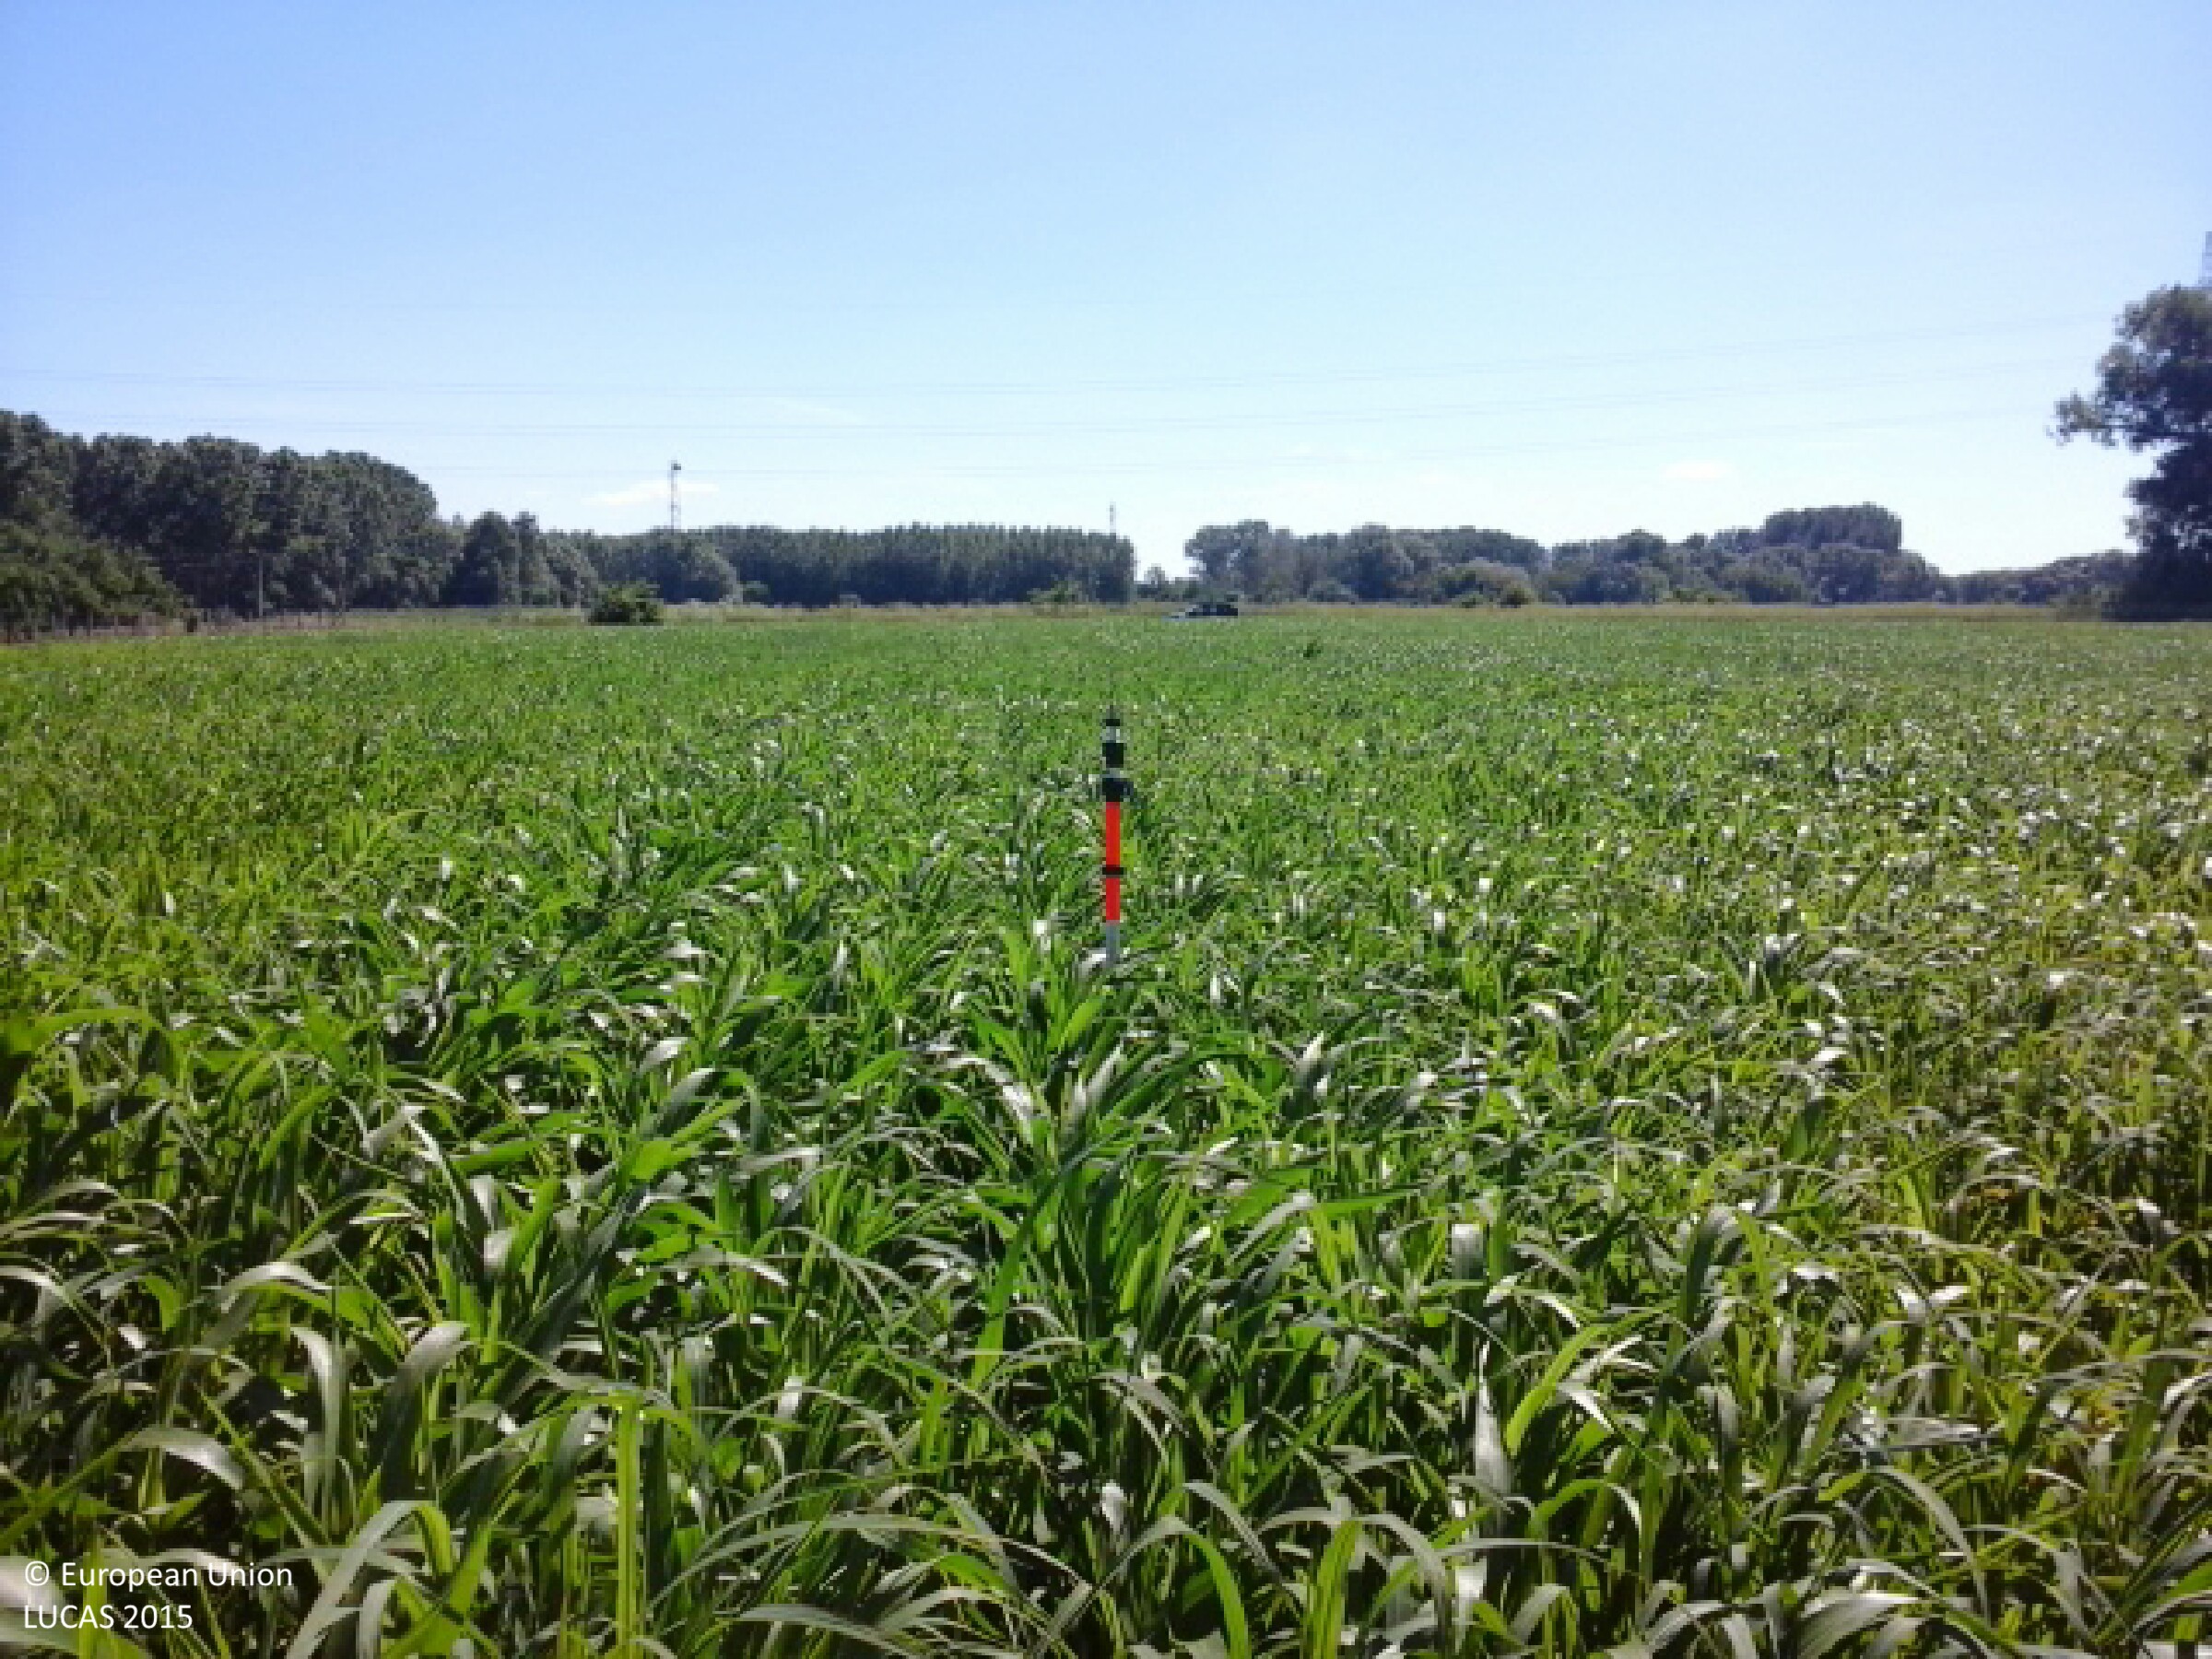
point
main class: Cropland
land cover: Maize
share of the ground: > 75 %
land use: Agriculture (excluding fallow land and kitchen gardens)
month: July
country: HU
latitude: 48.2329
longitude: 22.0494
